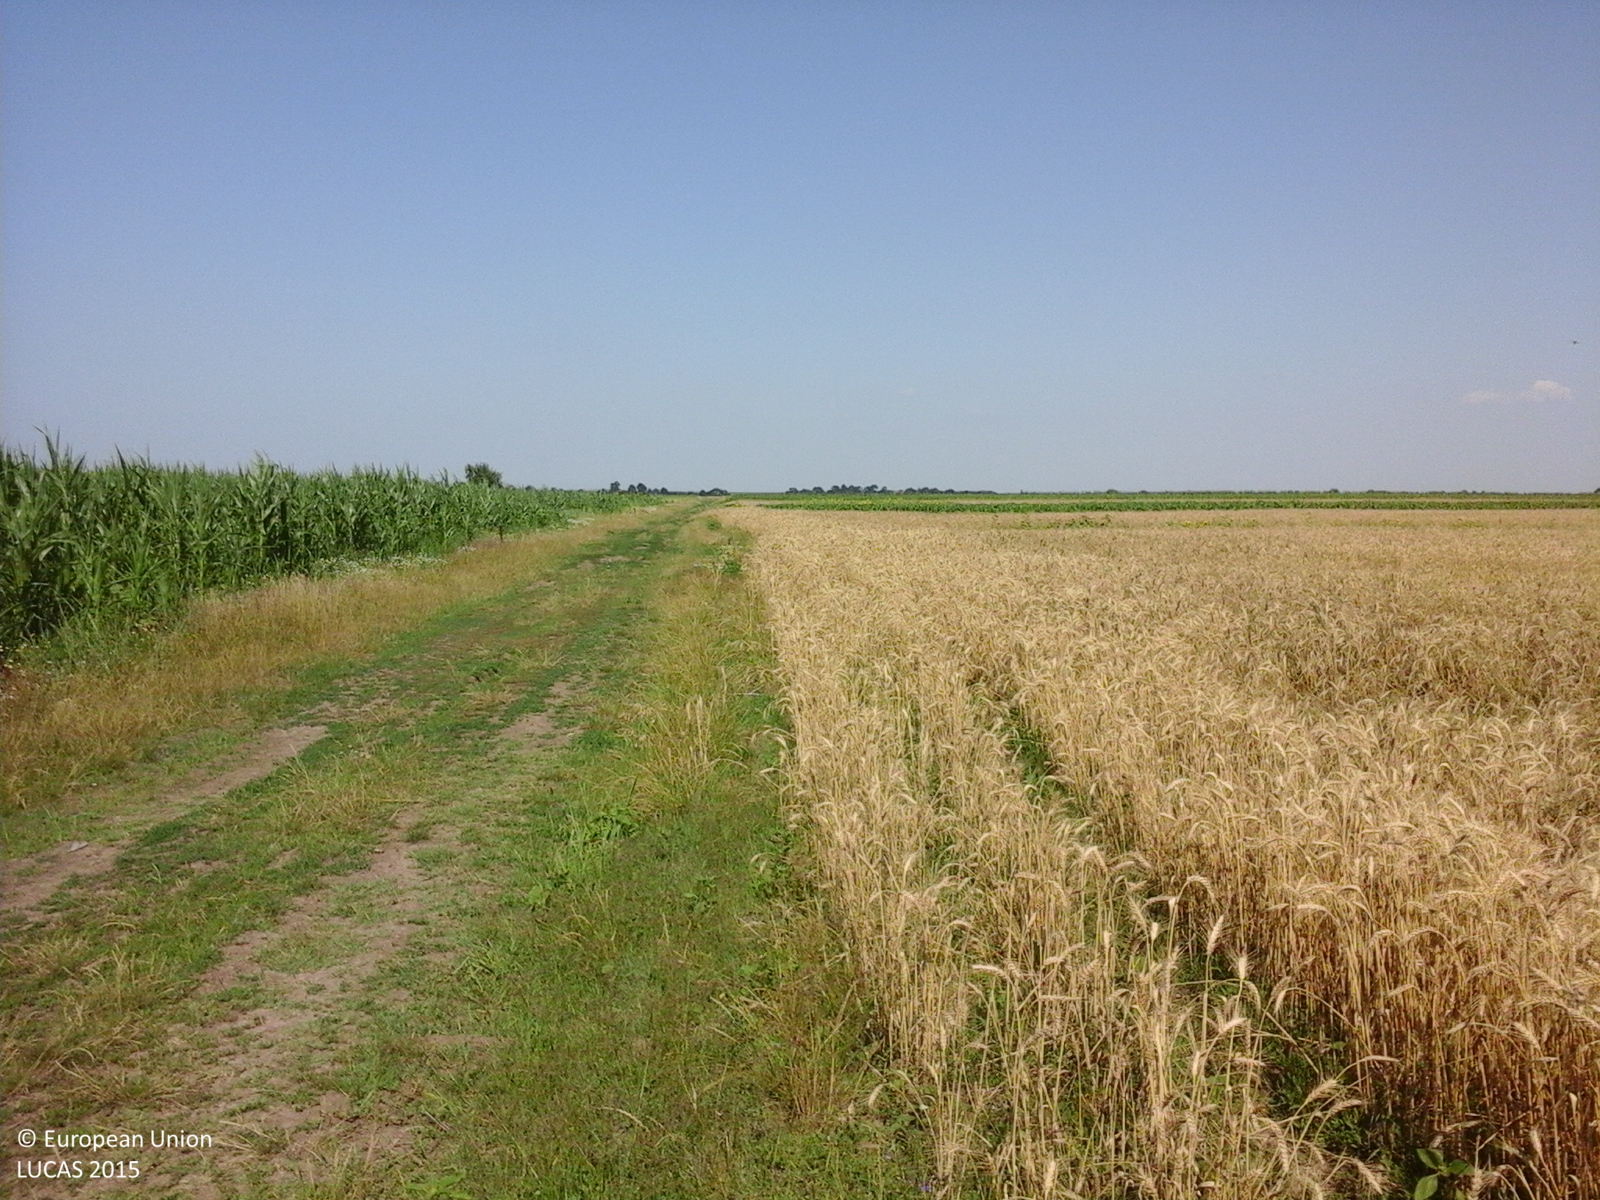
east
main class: Cropland
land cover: Common wheat
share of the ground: > 75 %
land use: Agriculture (excluding fallow land and kitchen gardens)
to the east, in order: Common wheat; Maize; Common wheat; Sunflower; Maize; Sunflower; Maize
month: July
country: RO
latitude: 44.3707
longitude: 24.6168
